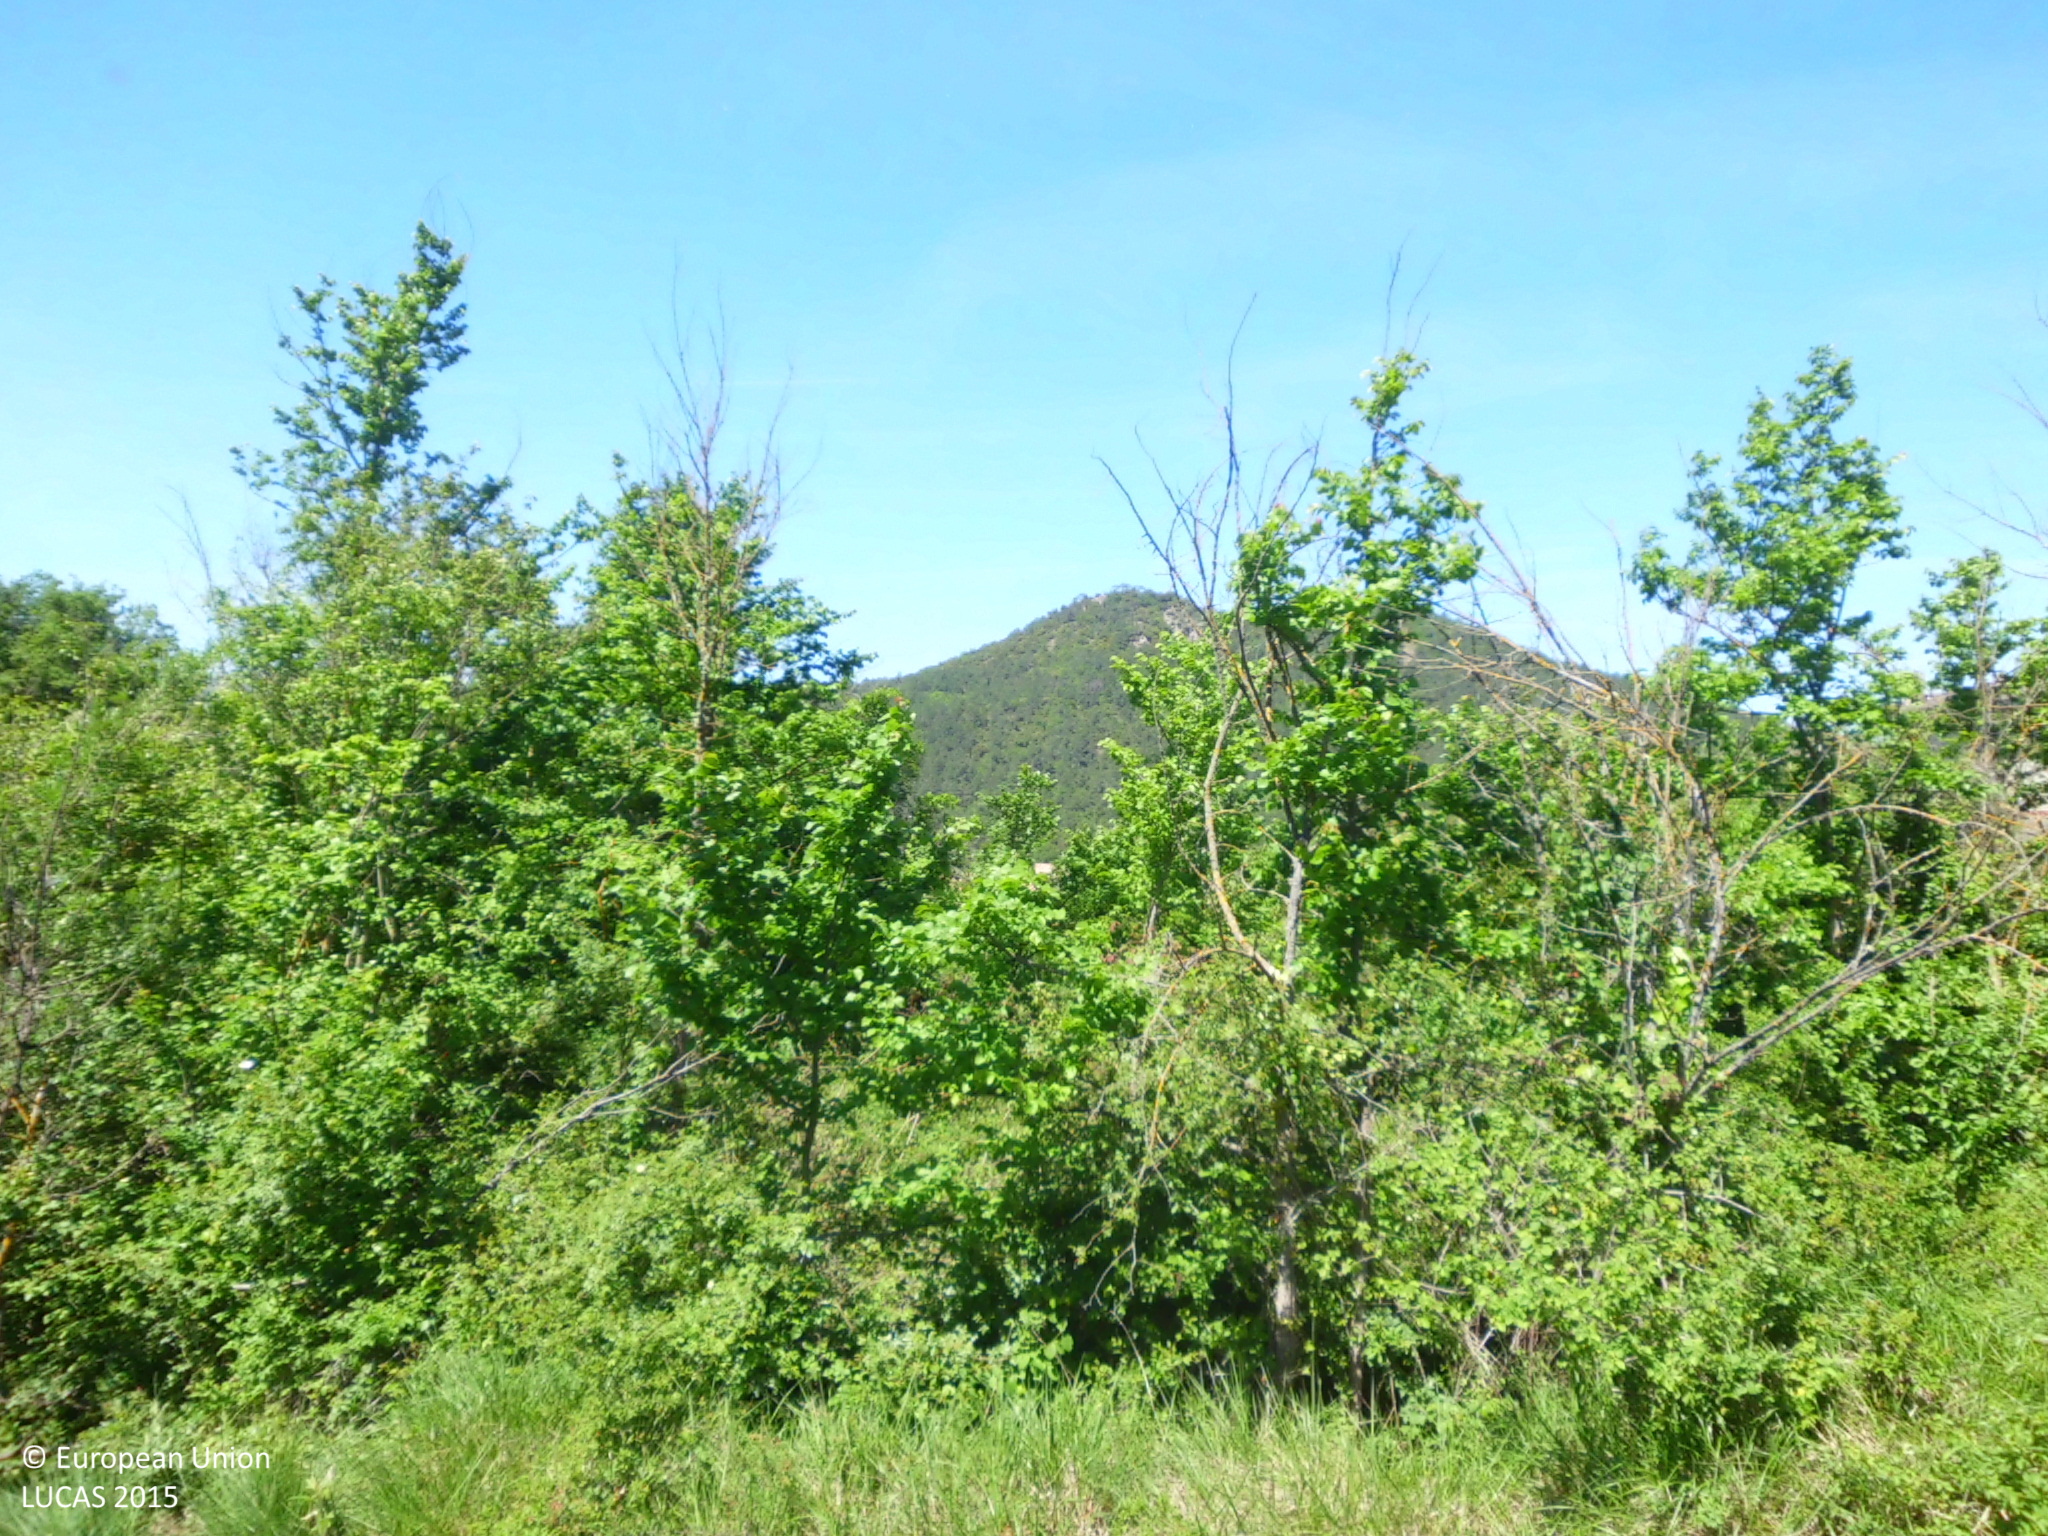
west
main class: Woodland
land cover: Other mixed woodland
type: acidophilous oak and oak-birch forest
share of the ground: > 75 %
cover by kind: broadleaved forest trees 60 %, coniferous forest trees 20 %, shrubs 20 %
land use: Semi-natural and natural areas not in use
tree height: > 5 m
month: May
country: ES
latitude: 42.7058
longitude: -3.4288
